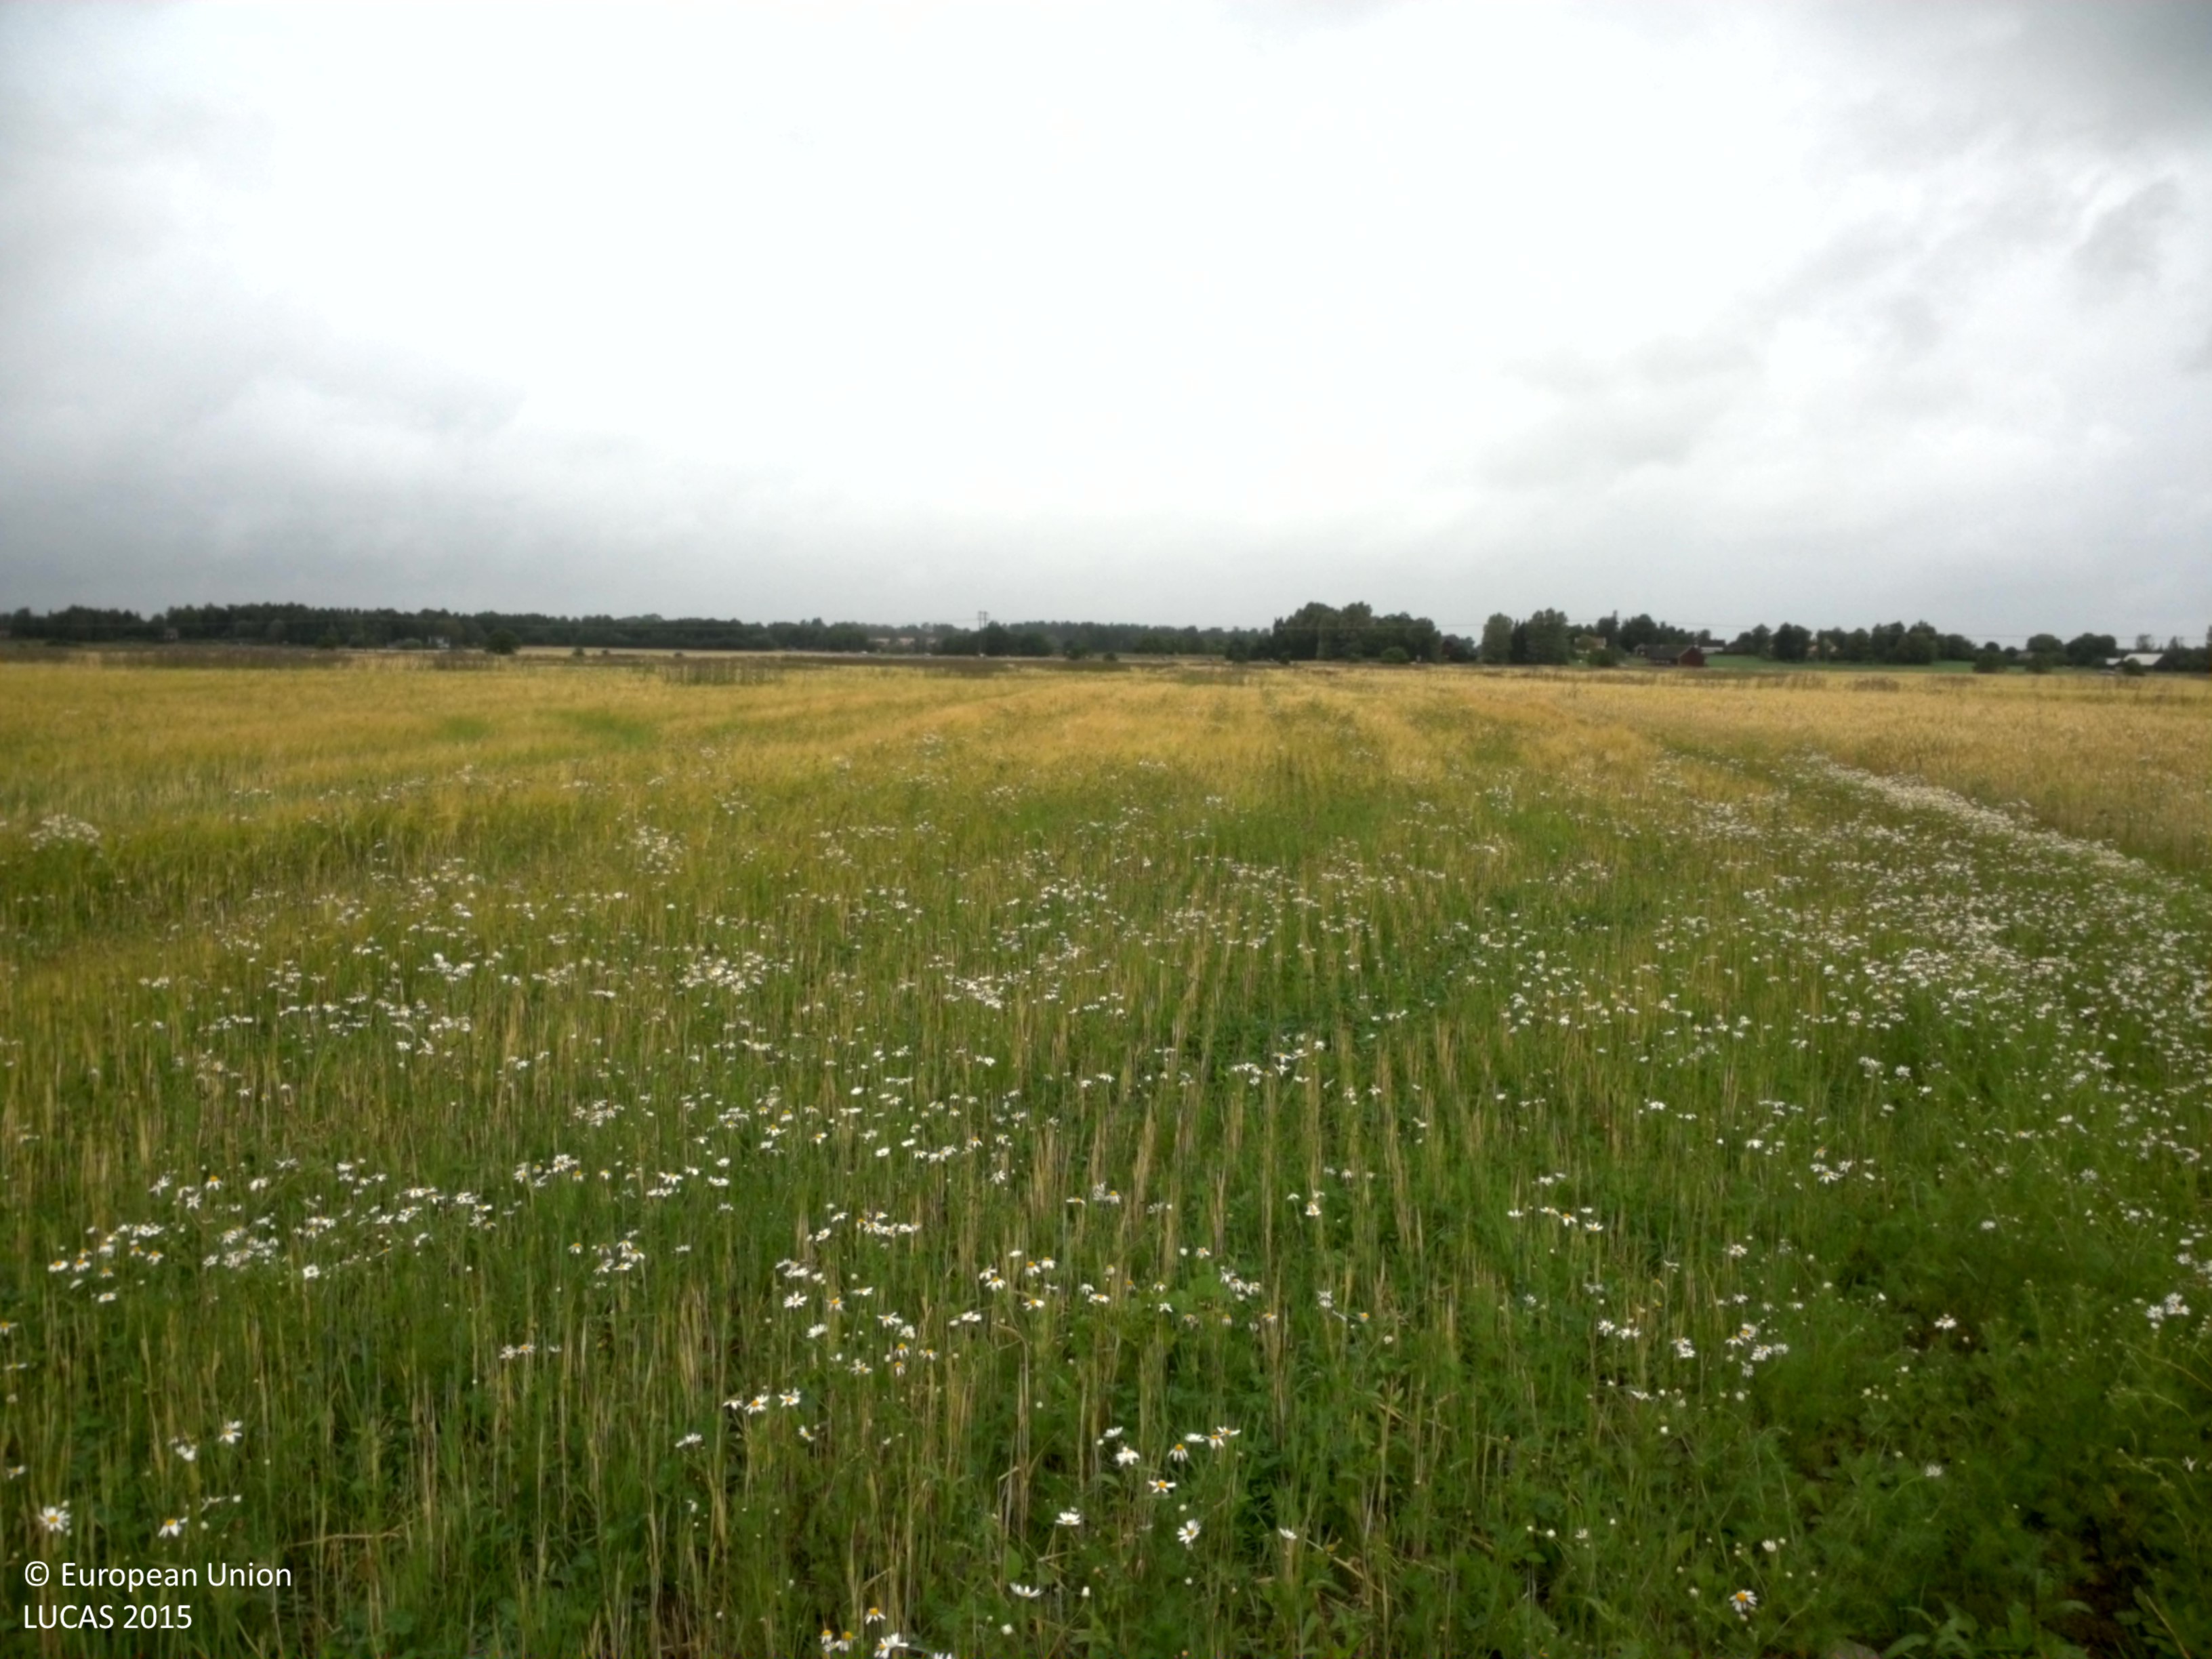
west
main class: Cropland
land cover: Barley
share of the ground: 25 - 50 %
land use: Agriculture (excluding fallow land and kitchen gardens)
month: July
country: SE
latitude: 58.7379
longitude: 13.9493
